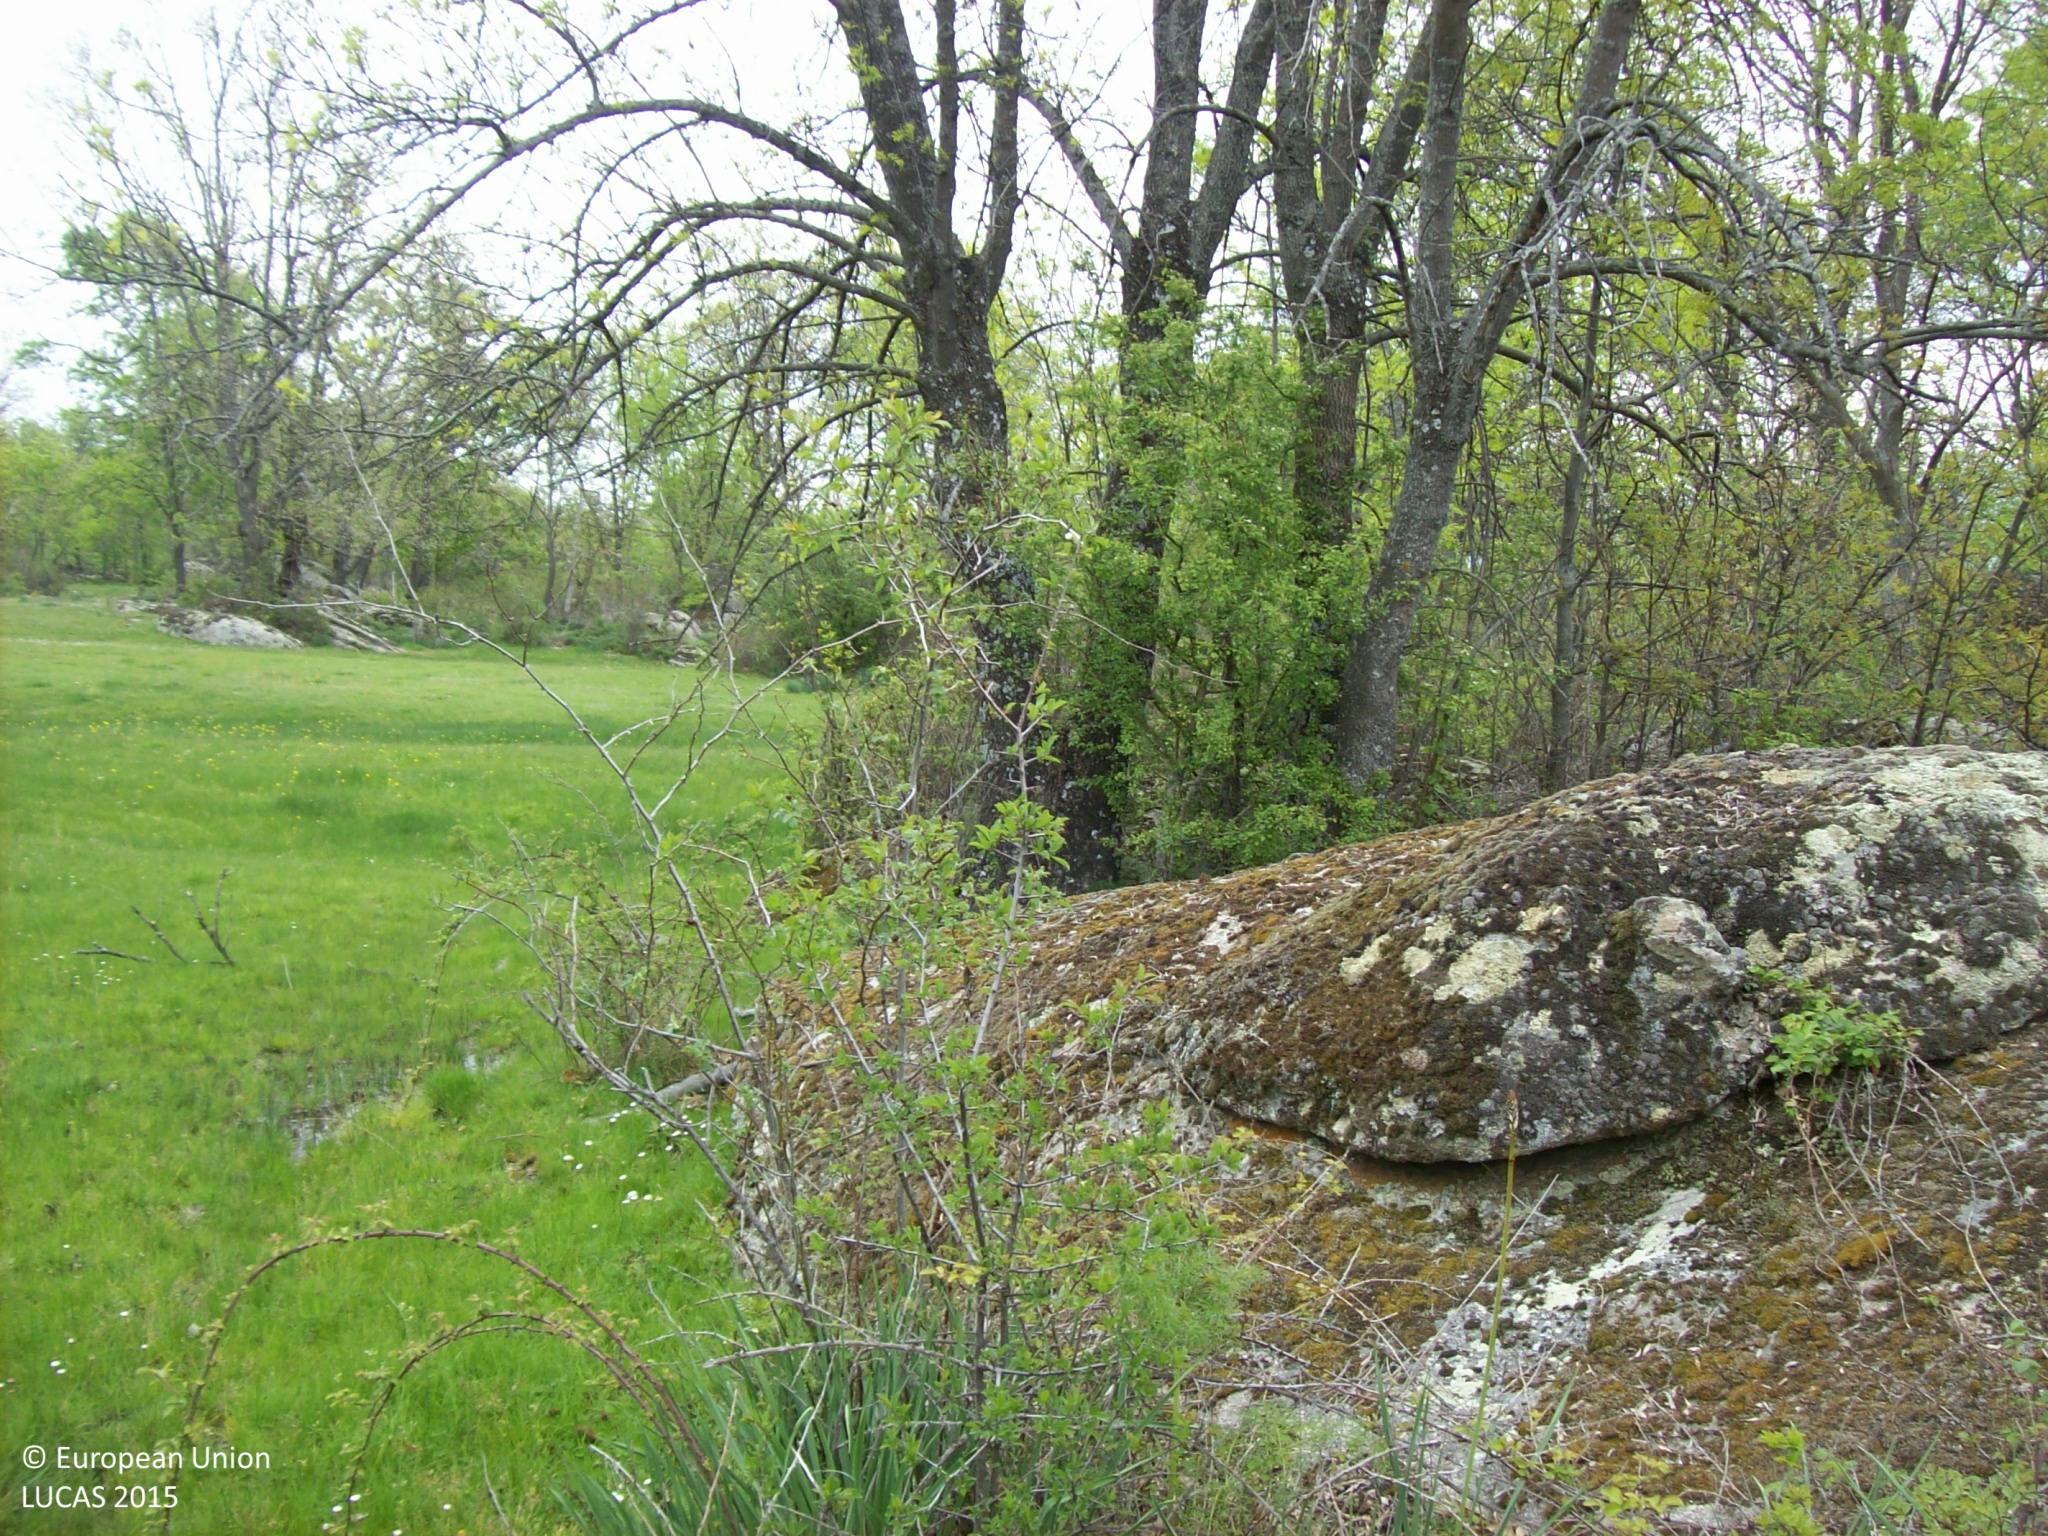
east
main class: Woodland
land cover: Broadleaved woodland
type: acidophilous oak and oak-birch forest
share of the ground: 10 - 25 %
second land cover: Grassland without tree/shrub cover
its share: > 75 %
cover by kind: herbaceous plants 40 %, consolidated bare surface 25 %, broadleaved forest trees 20 %, shrubs 15 %
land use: Forestry
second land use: Agriculture (excluding fallow land and kitchen gardens)
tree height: > 5 m
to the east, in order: Broadleaved woodland; Grassland without tree/shrub cover; Rock outcrops; Broadleaved woodland; Grassland with sparse tree/shrub cover; Tracks; Rock outcrops; Broadleaved woodland; Rock outcrops; Dry stone walls; Fences; Broadleaved woodland
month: April
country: ES
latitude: 40.4372
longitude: -4.8259
